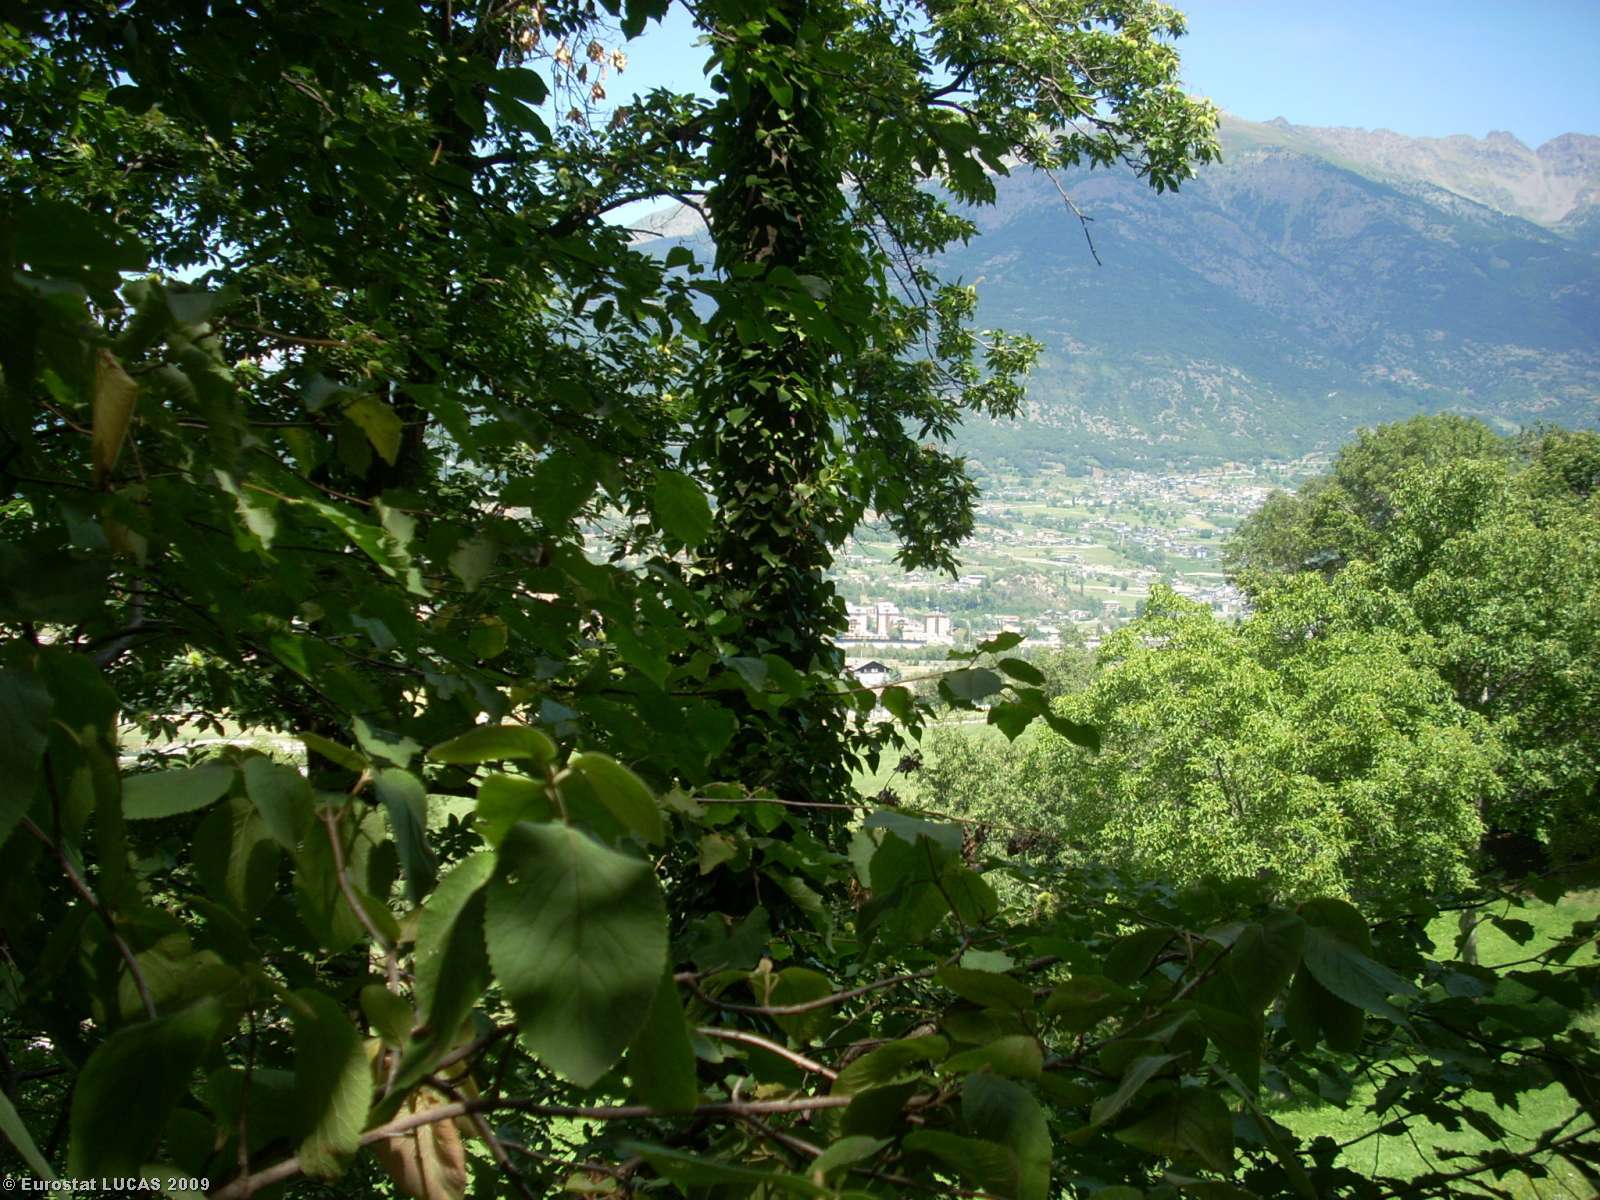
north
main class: Woodland
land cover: Mixed woodland
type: mesophytic deciduous forest
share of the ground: > 75 %
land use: Forestry
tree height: > 5 m
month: July
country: IT
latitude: 45.7234
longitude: 7.3440
